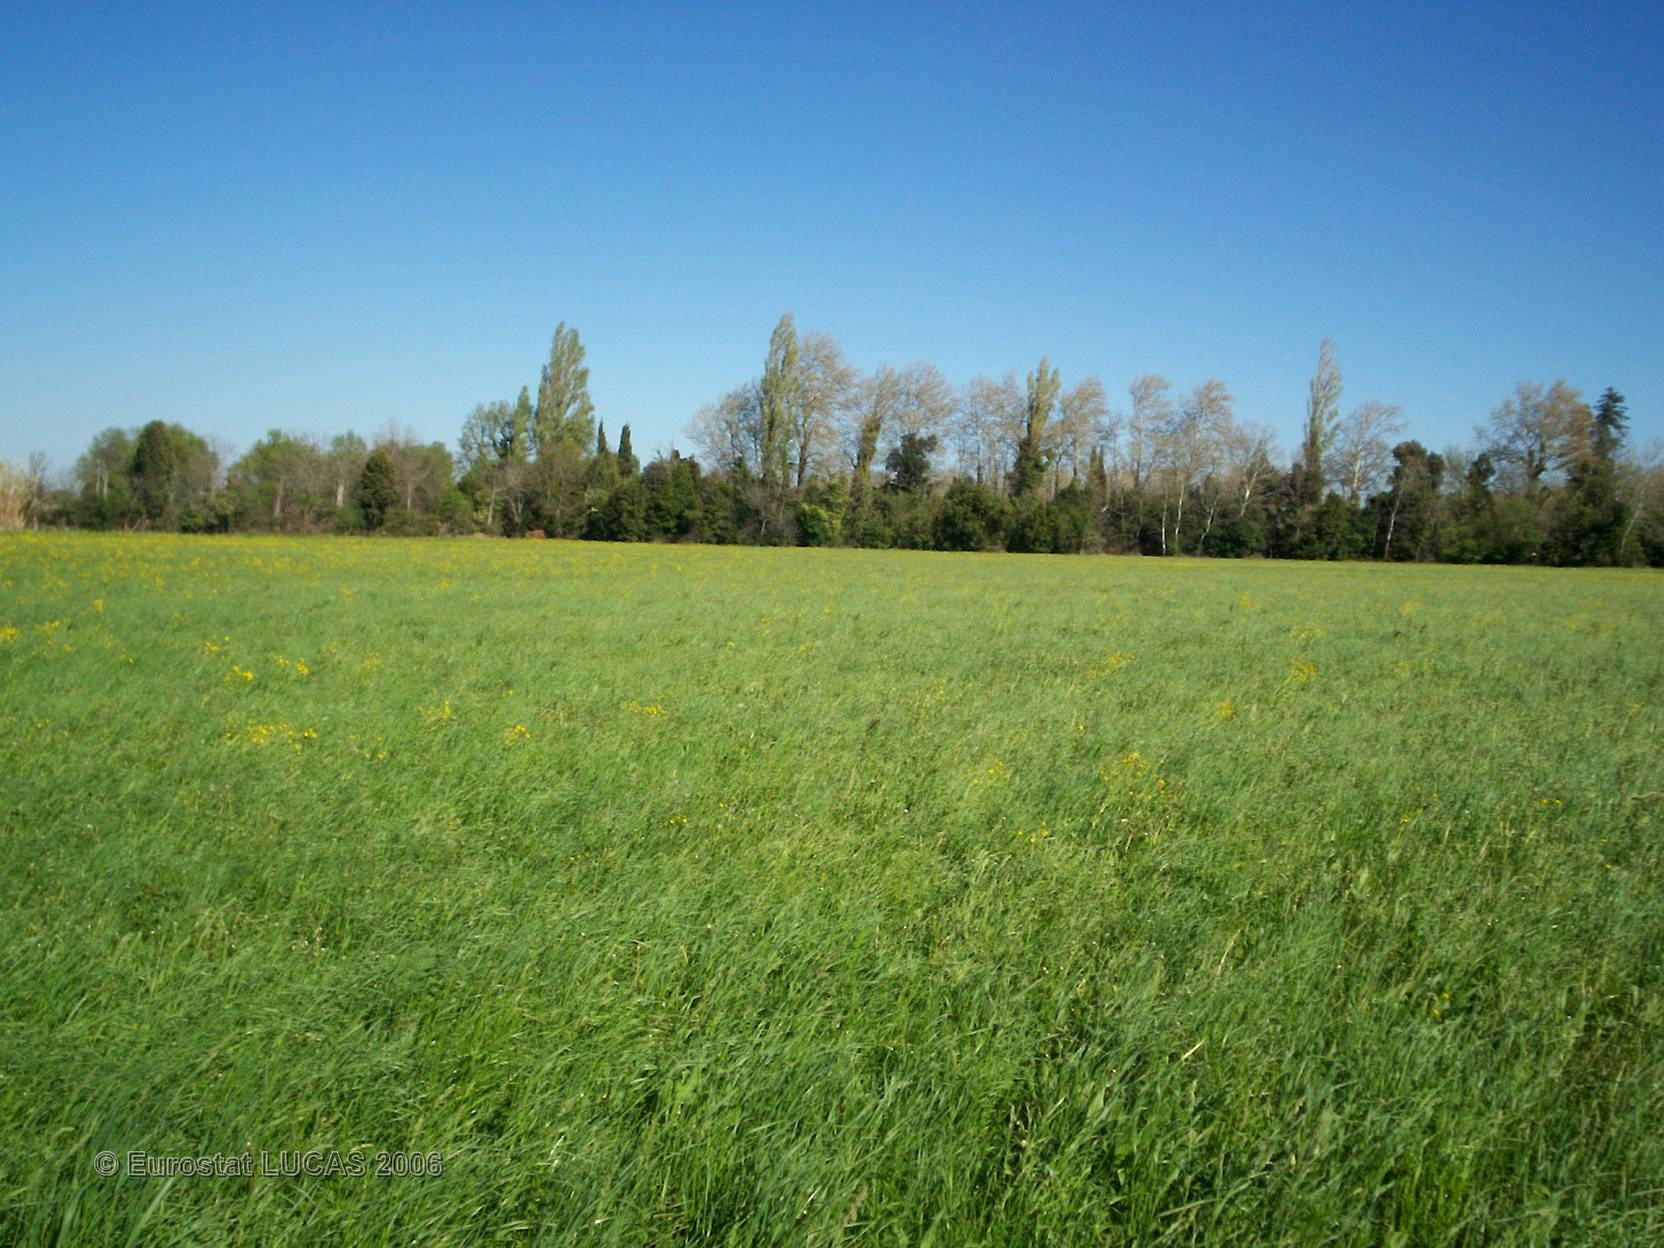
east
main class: Grassland
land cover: Grassland without tree/shrub cover
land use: Agriculture (excluding fallow land and kitchen gardens)
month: April
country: FR
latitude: 43.5600
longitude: 4.9712
